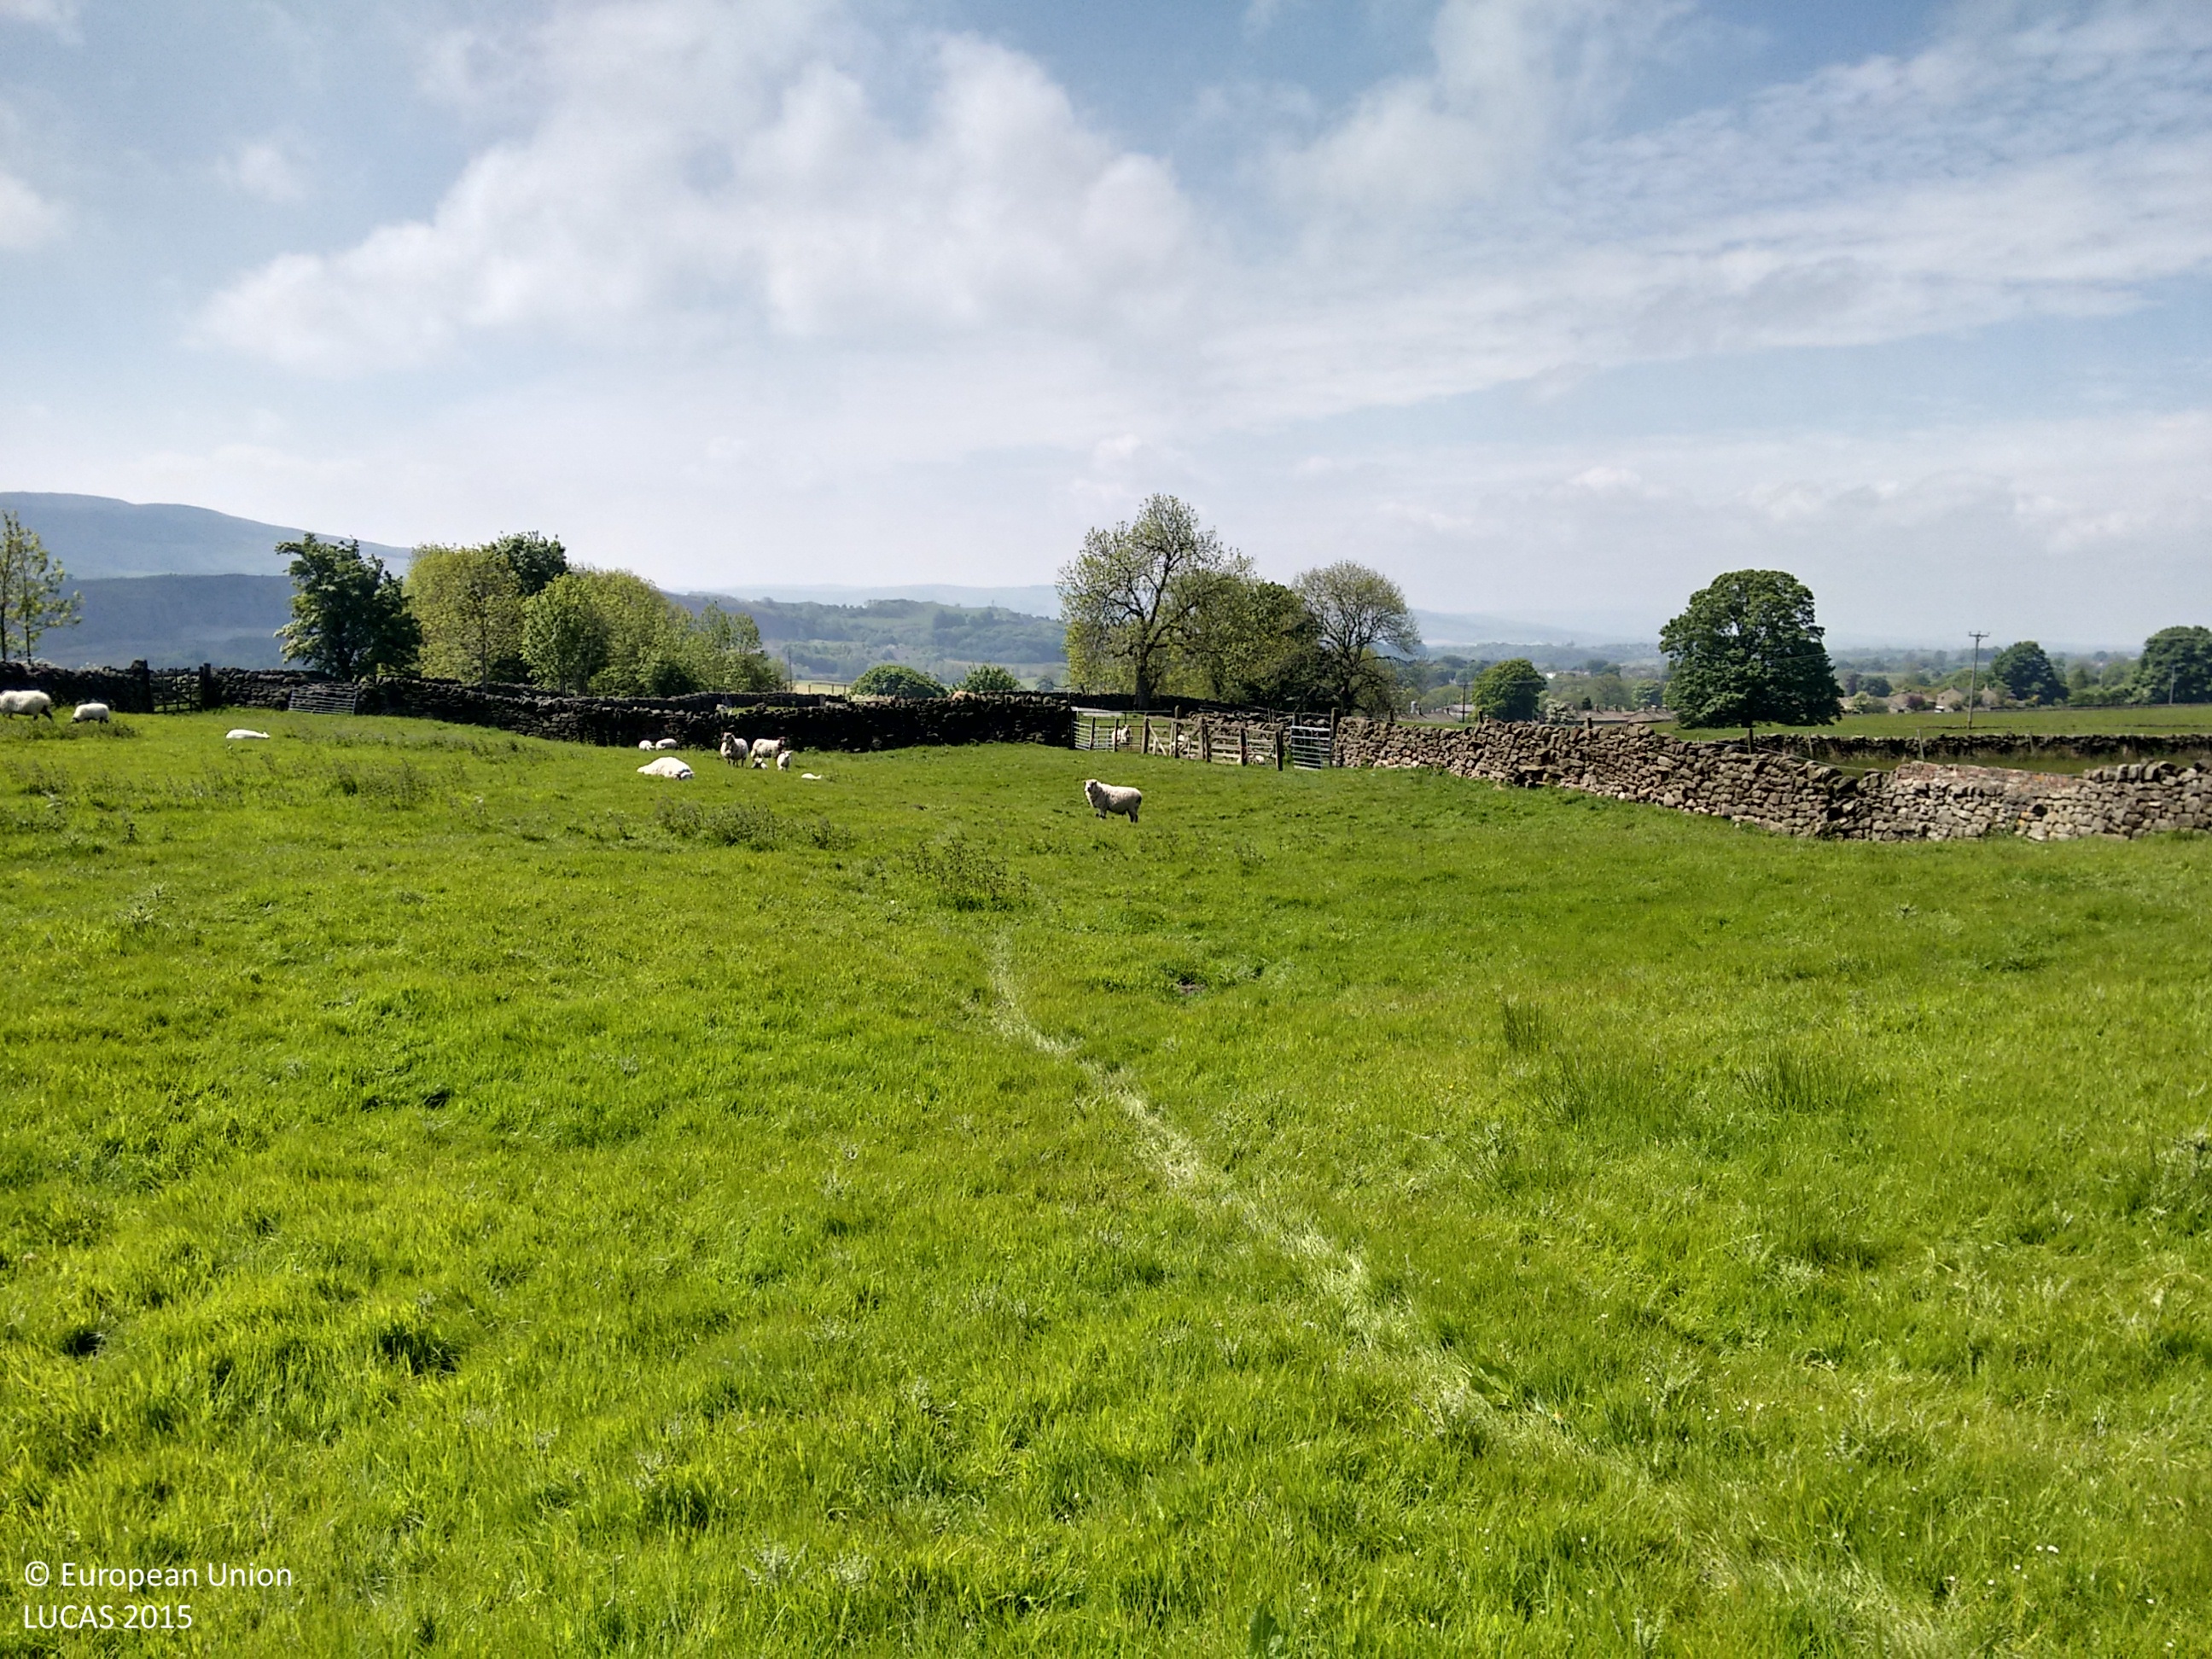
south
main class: Grassland
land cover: Grassland without tree/shrub cover
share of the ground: > 75 %
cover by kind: herbaceous plants 100 %
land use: Agriculture (excluding fallow land and kitchen gardens)
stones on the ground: < 10 %
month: June
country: GB
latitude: 53.9880
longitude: -1.9675
